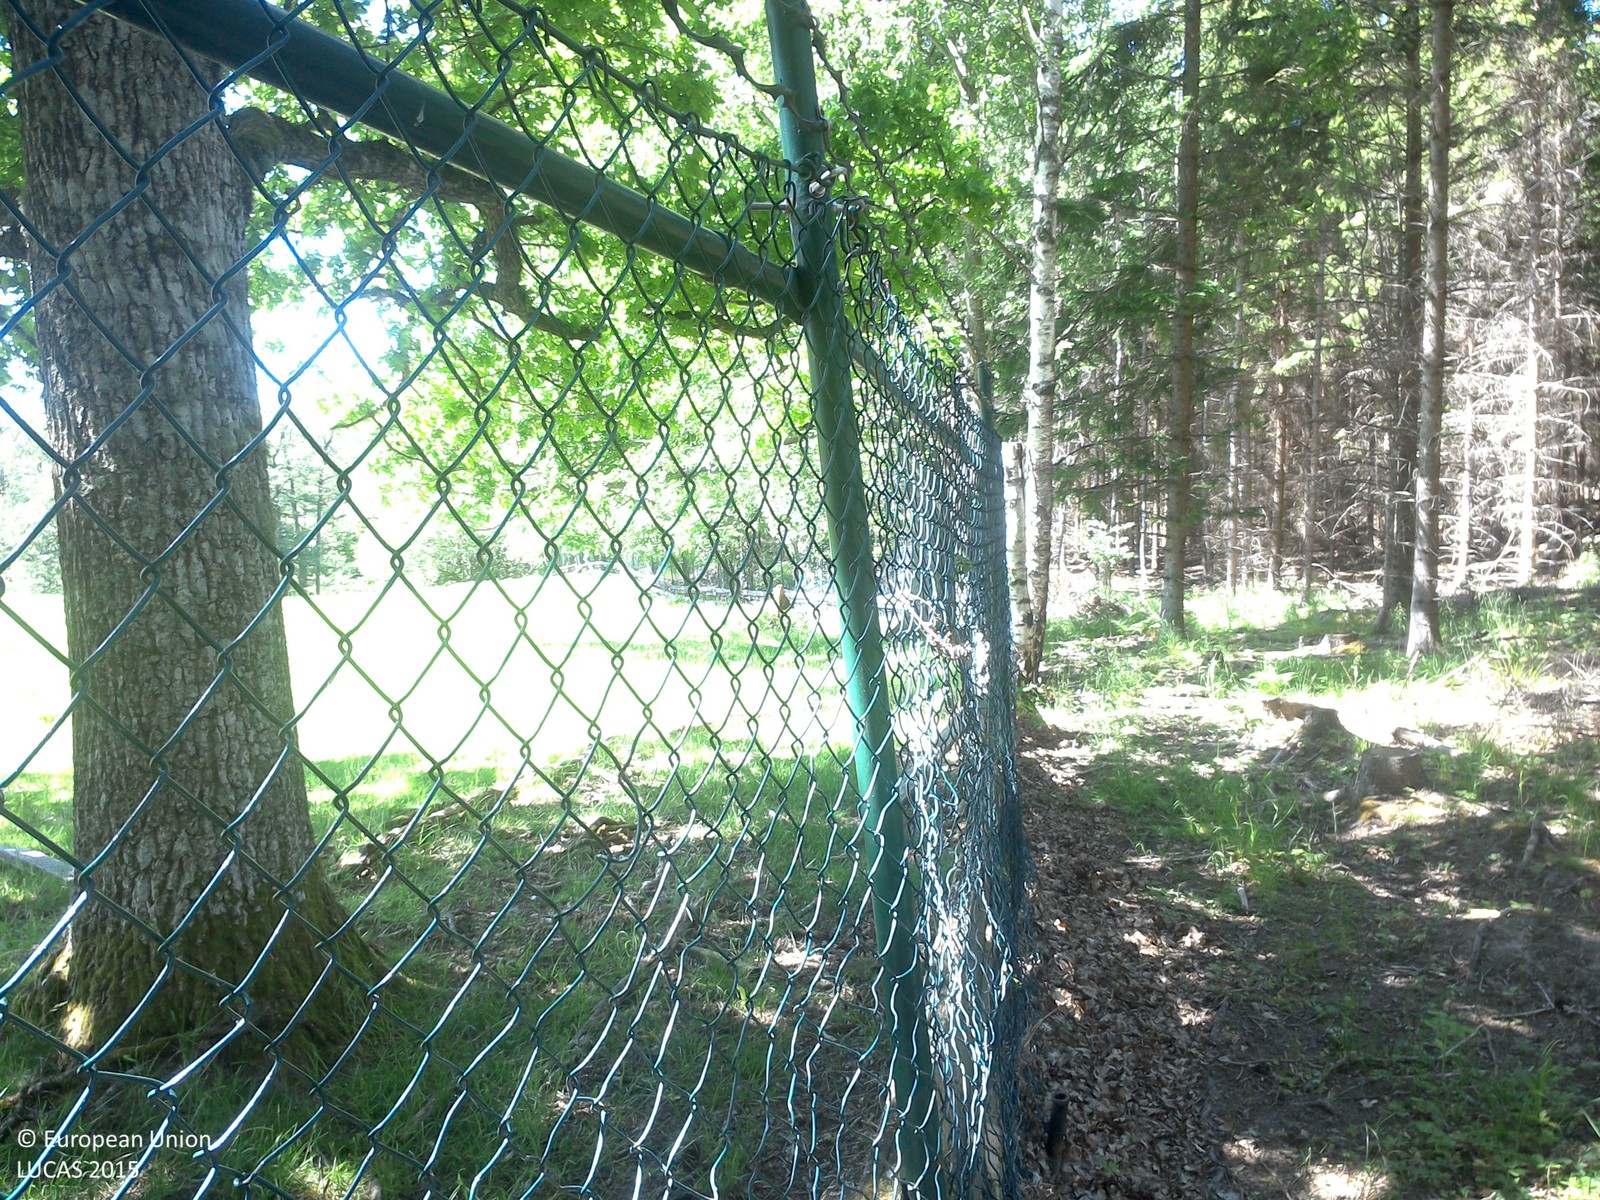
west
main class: Woodland
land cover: Spruce dominated mixed woodland
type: boreal forest
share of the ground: 50 - 75 %
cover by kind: coniferous forest trees 50 %, broadleaved forest trees 25 %, herbaceous plants 25 %
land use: Forestry
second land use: Amenities, museums, leisure
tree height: > 5 m
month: June
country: SE
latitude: 58.2773
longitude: 15.7415
